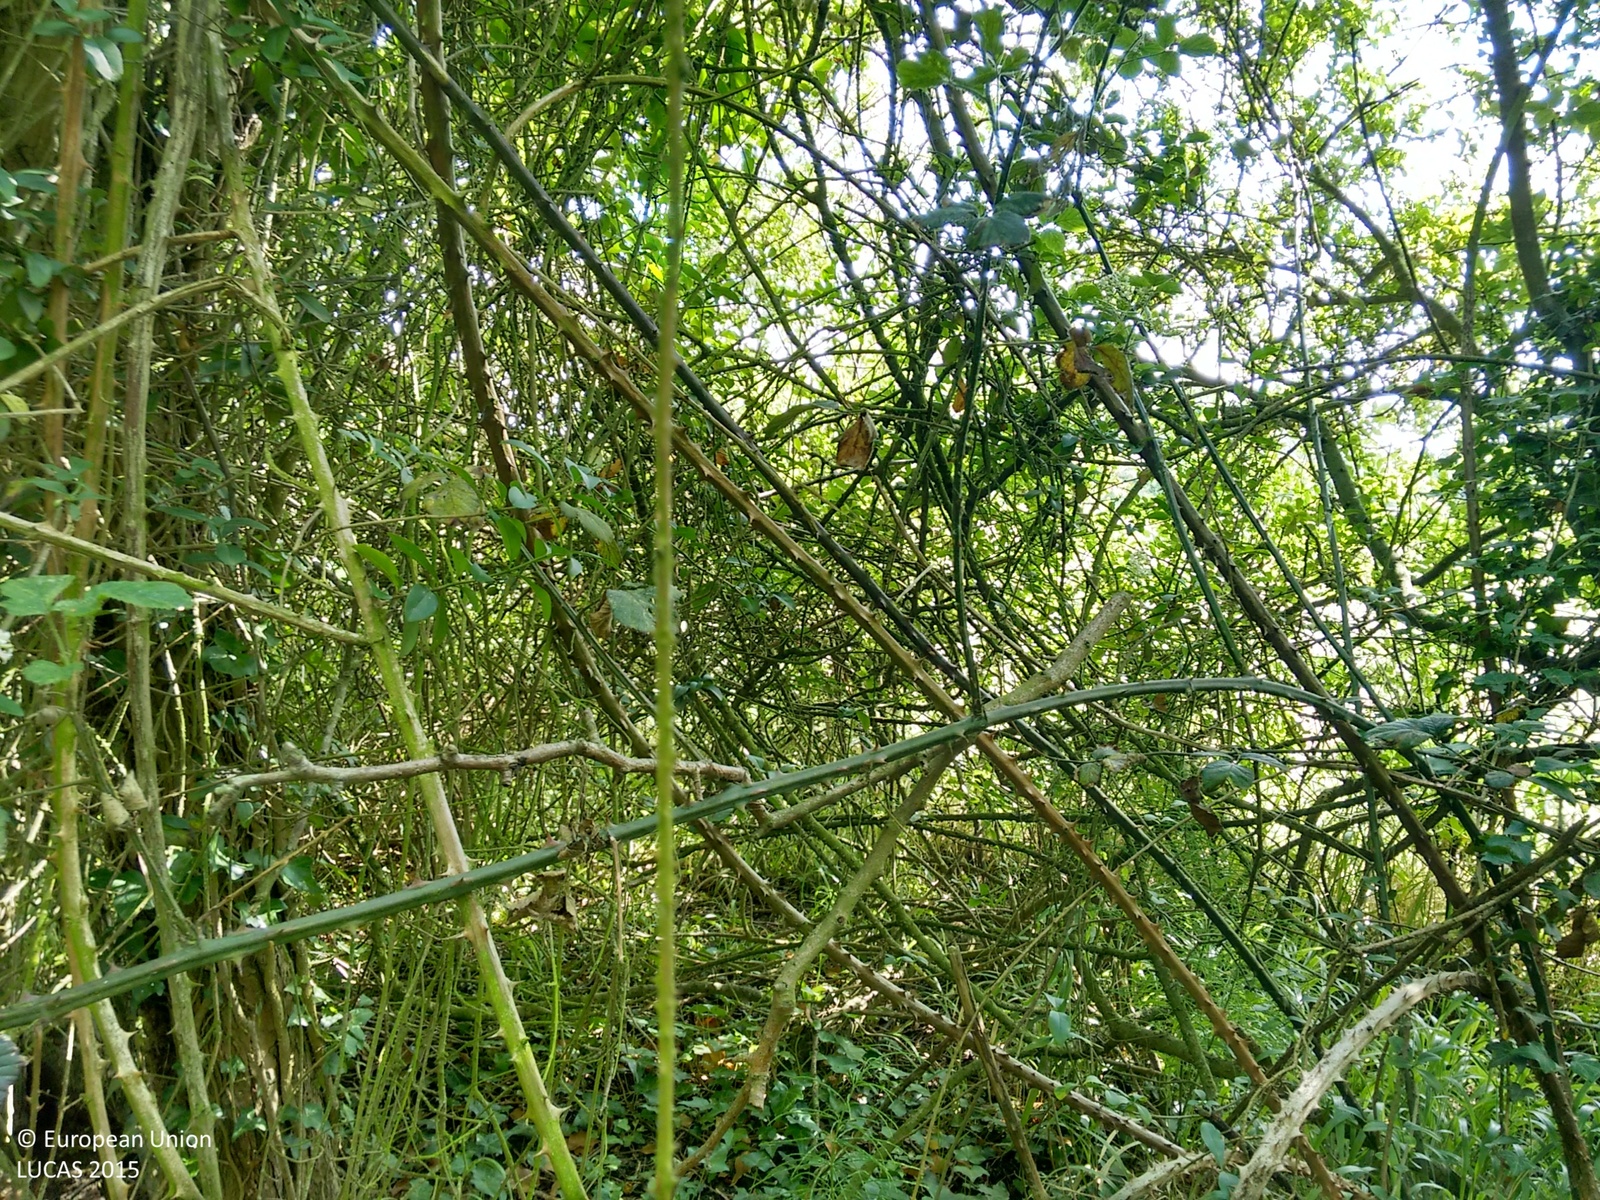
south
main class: Woodland
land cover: Broadleaved woodland
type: mesophytic deciduous forest
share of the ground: > 75 %
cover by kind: broadleaved forest trees 80 %, shrubs 10 %, herbaceous plants 10 %
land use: Semi-natural and natural areas not in use
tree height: > 5 m
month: July
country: GB
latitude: 51.6373
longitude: -1.0993
